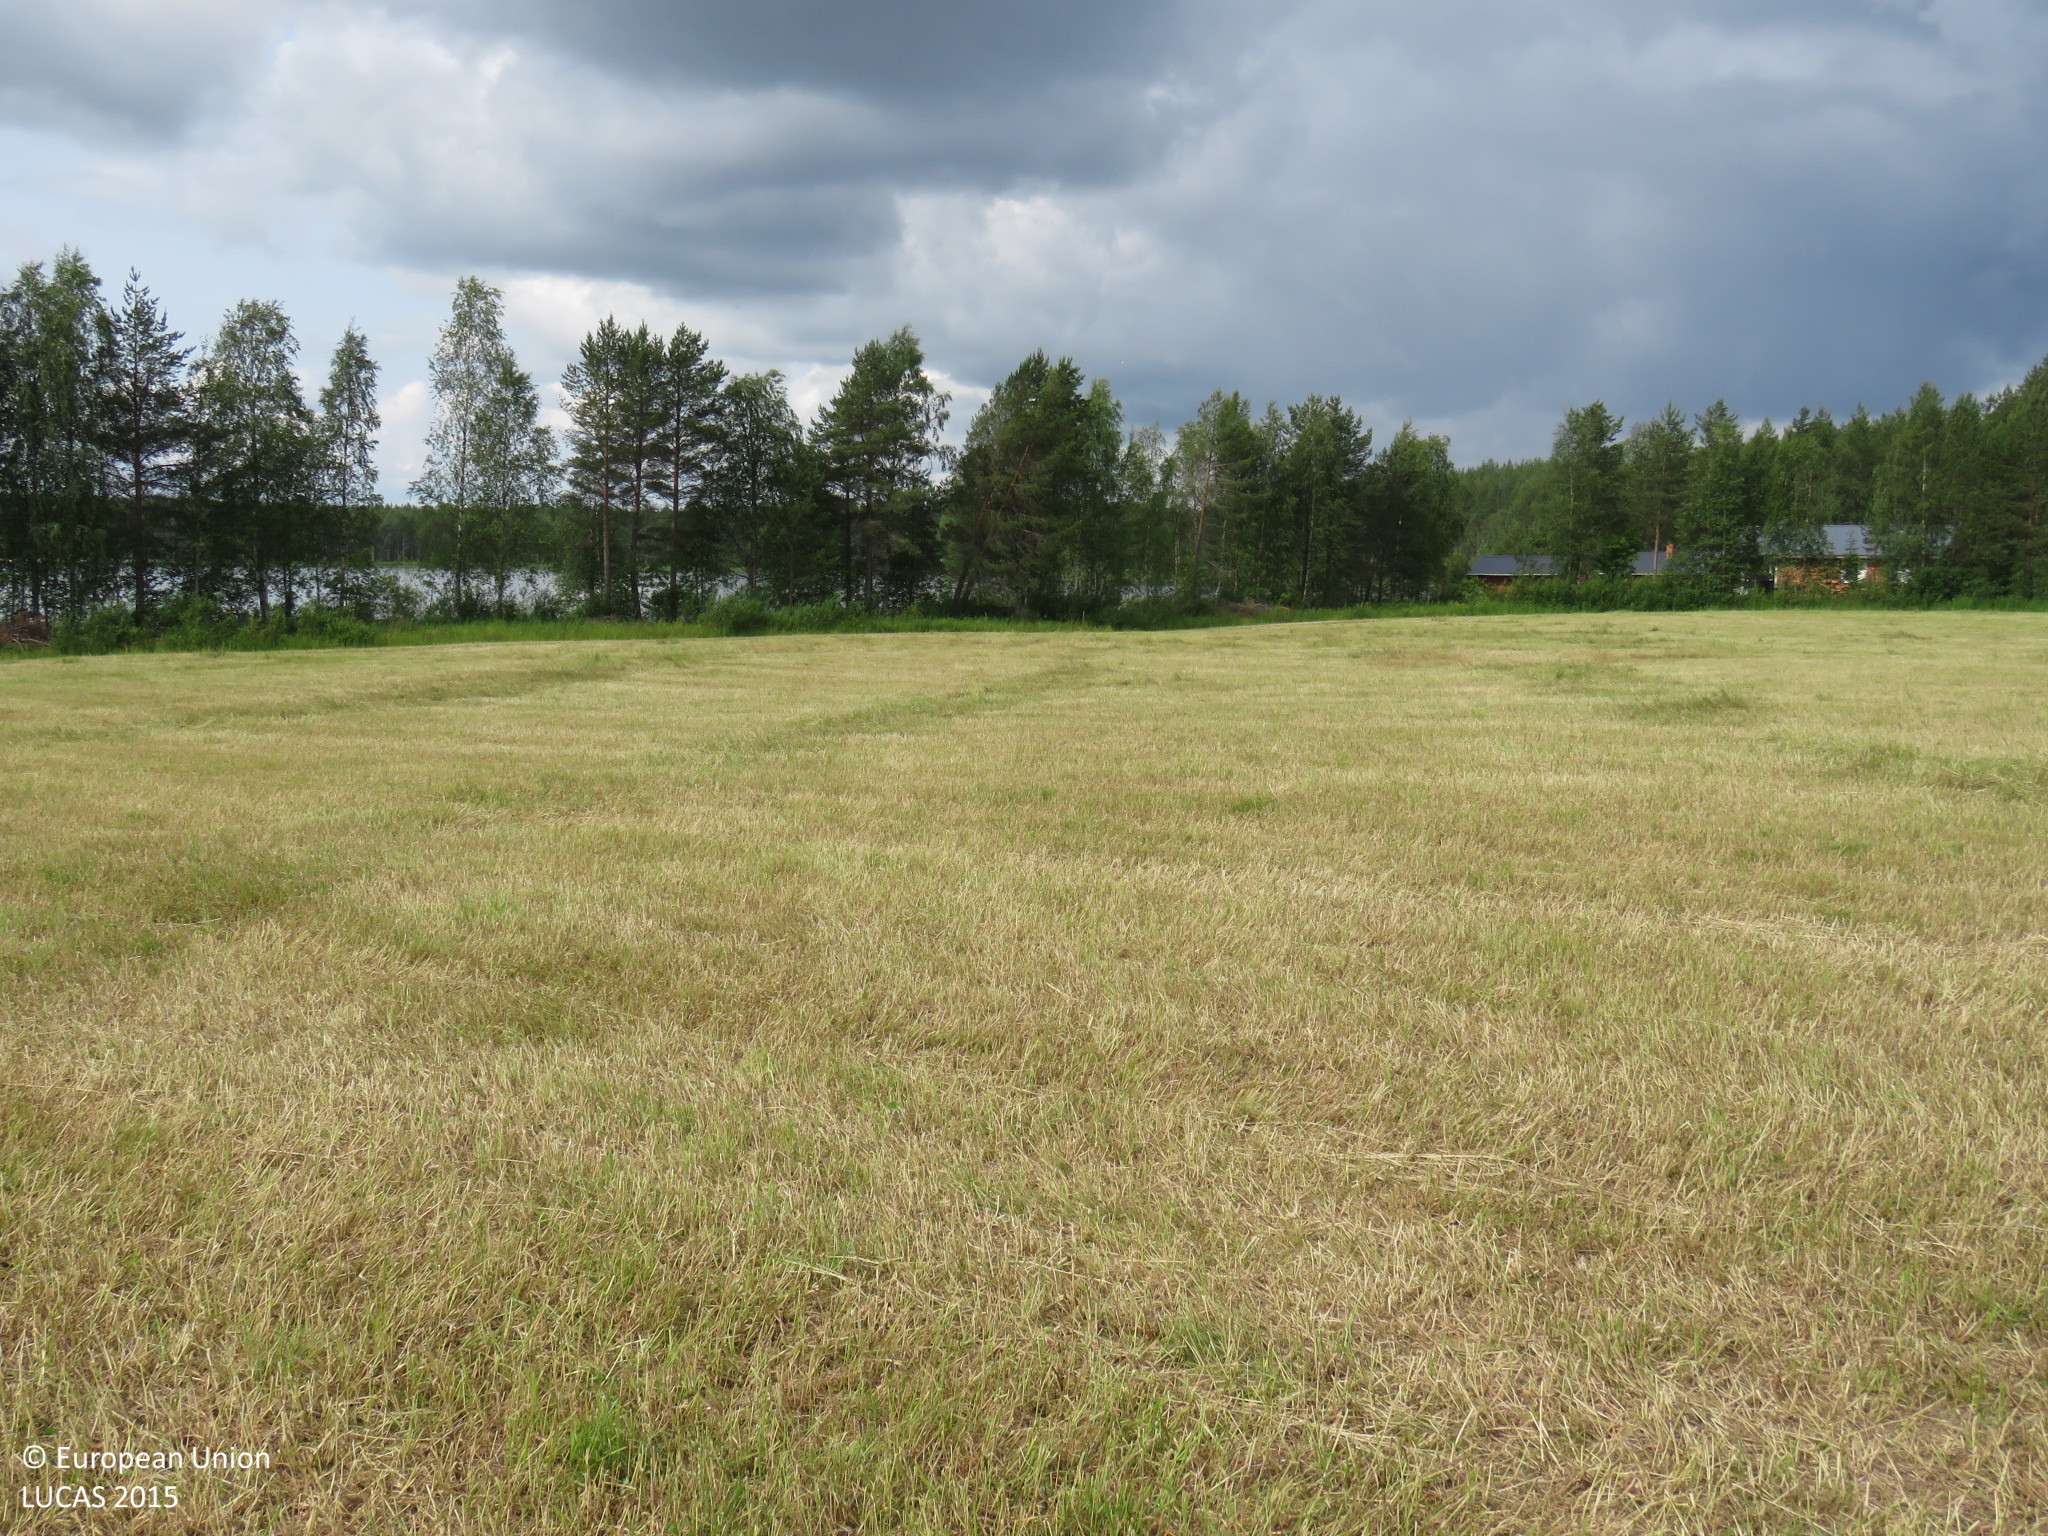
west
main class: Cropland
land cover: Temporary grasslands
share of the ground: > 75 %
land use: Agriculture (excluding fallow land and kitchen gardens)
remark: Harvested field
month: July
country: FI
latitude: 64.5345
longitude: 26.7766
